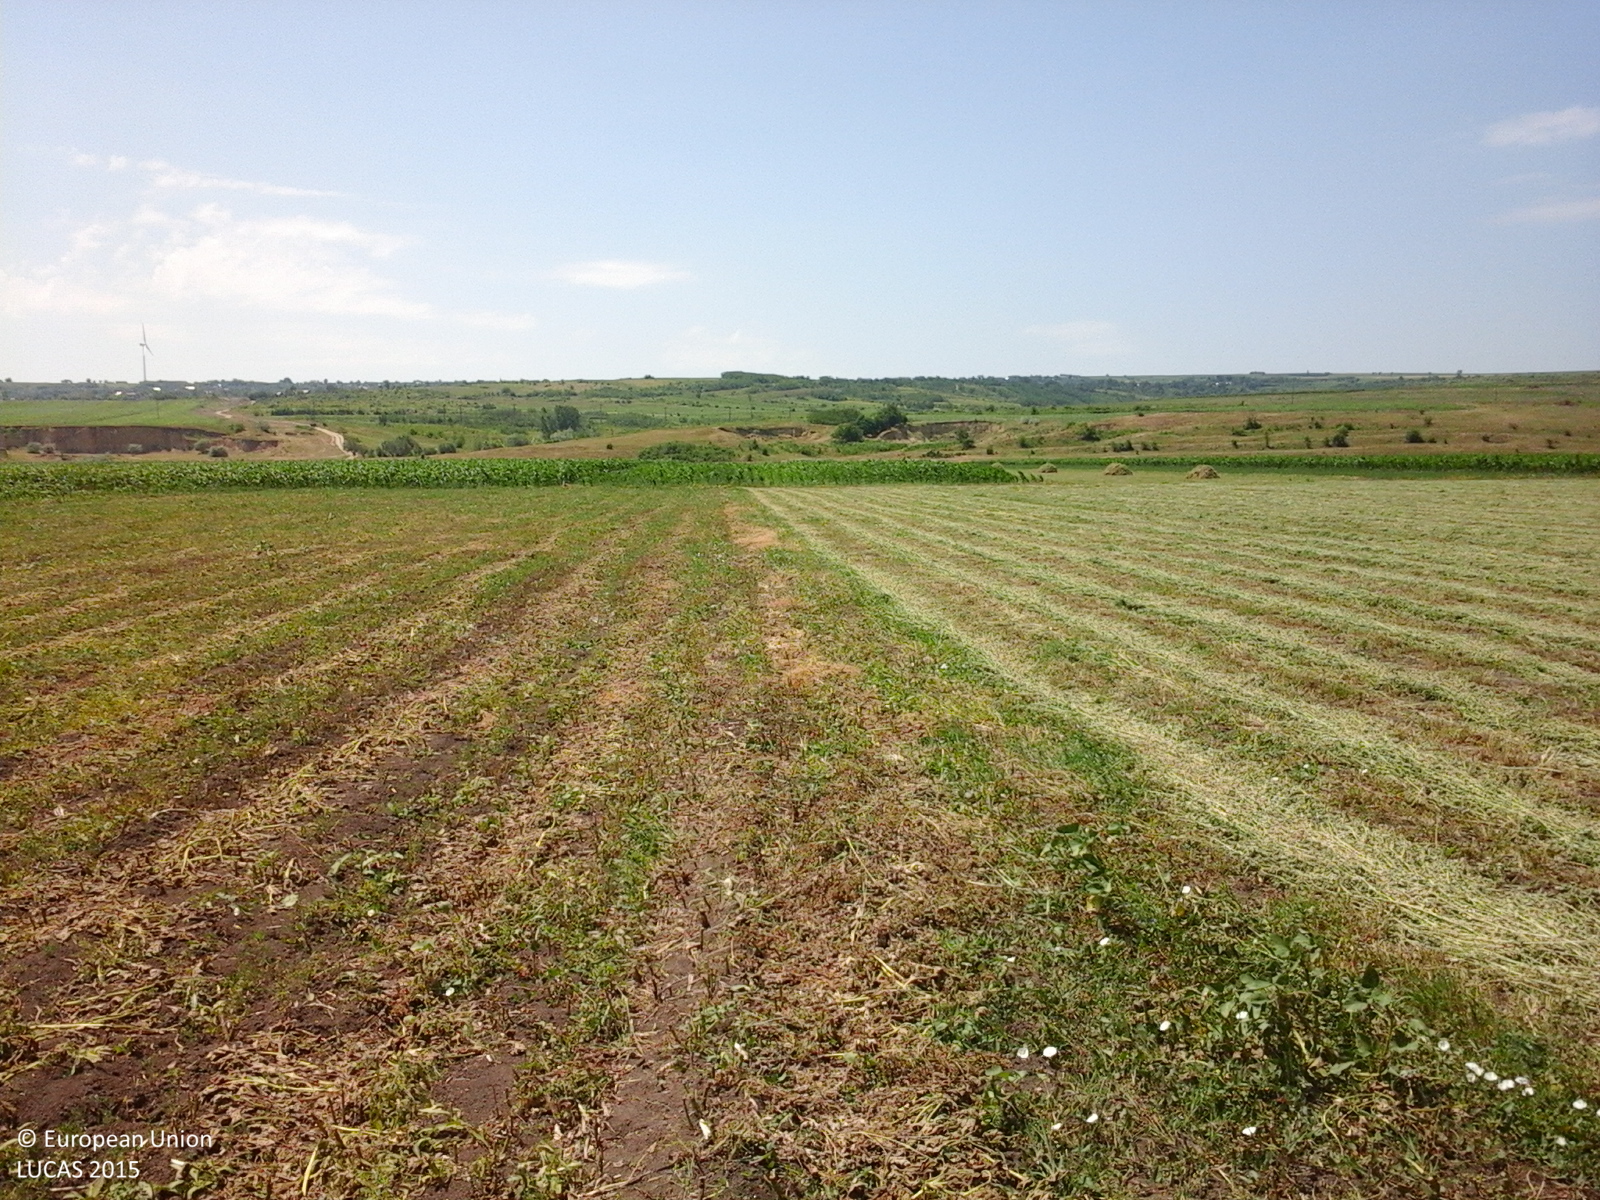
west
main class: Cropland
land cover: Lucerne
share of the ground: > 75 %
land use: Agriculture (excluding fallow land and kitchen gardens)
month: June
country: RO
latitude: 46.8359
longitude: 28.1080
